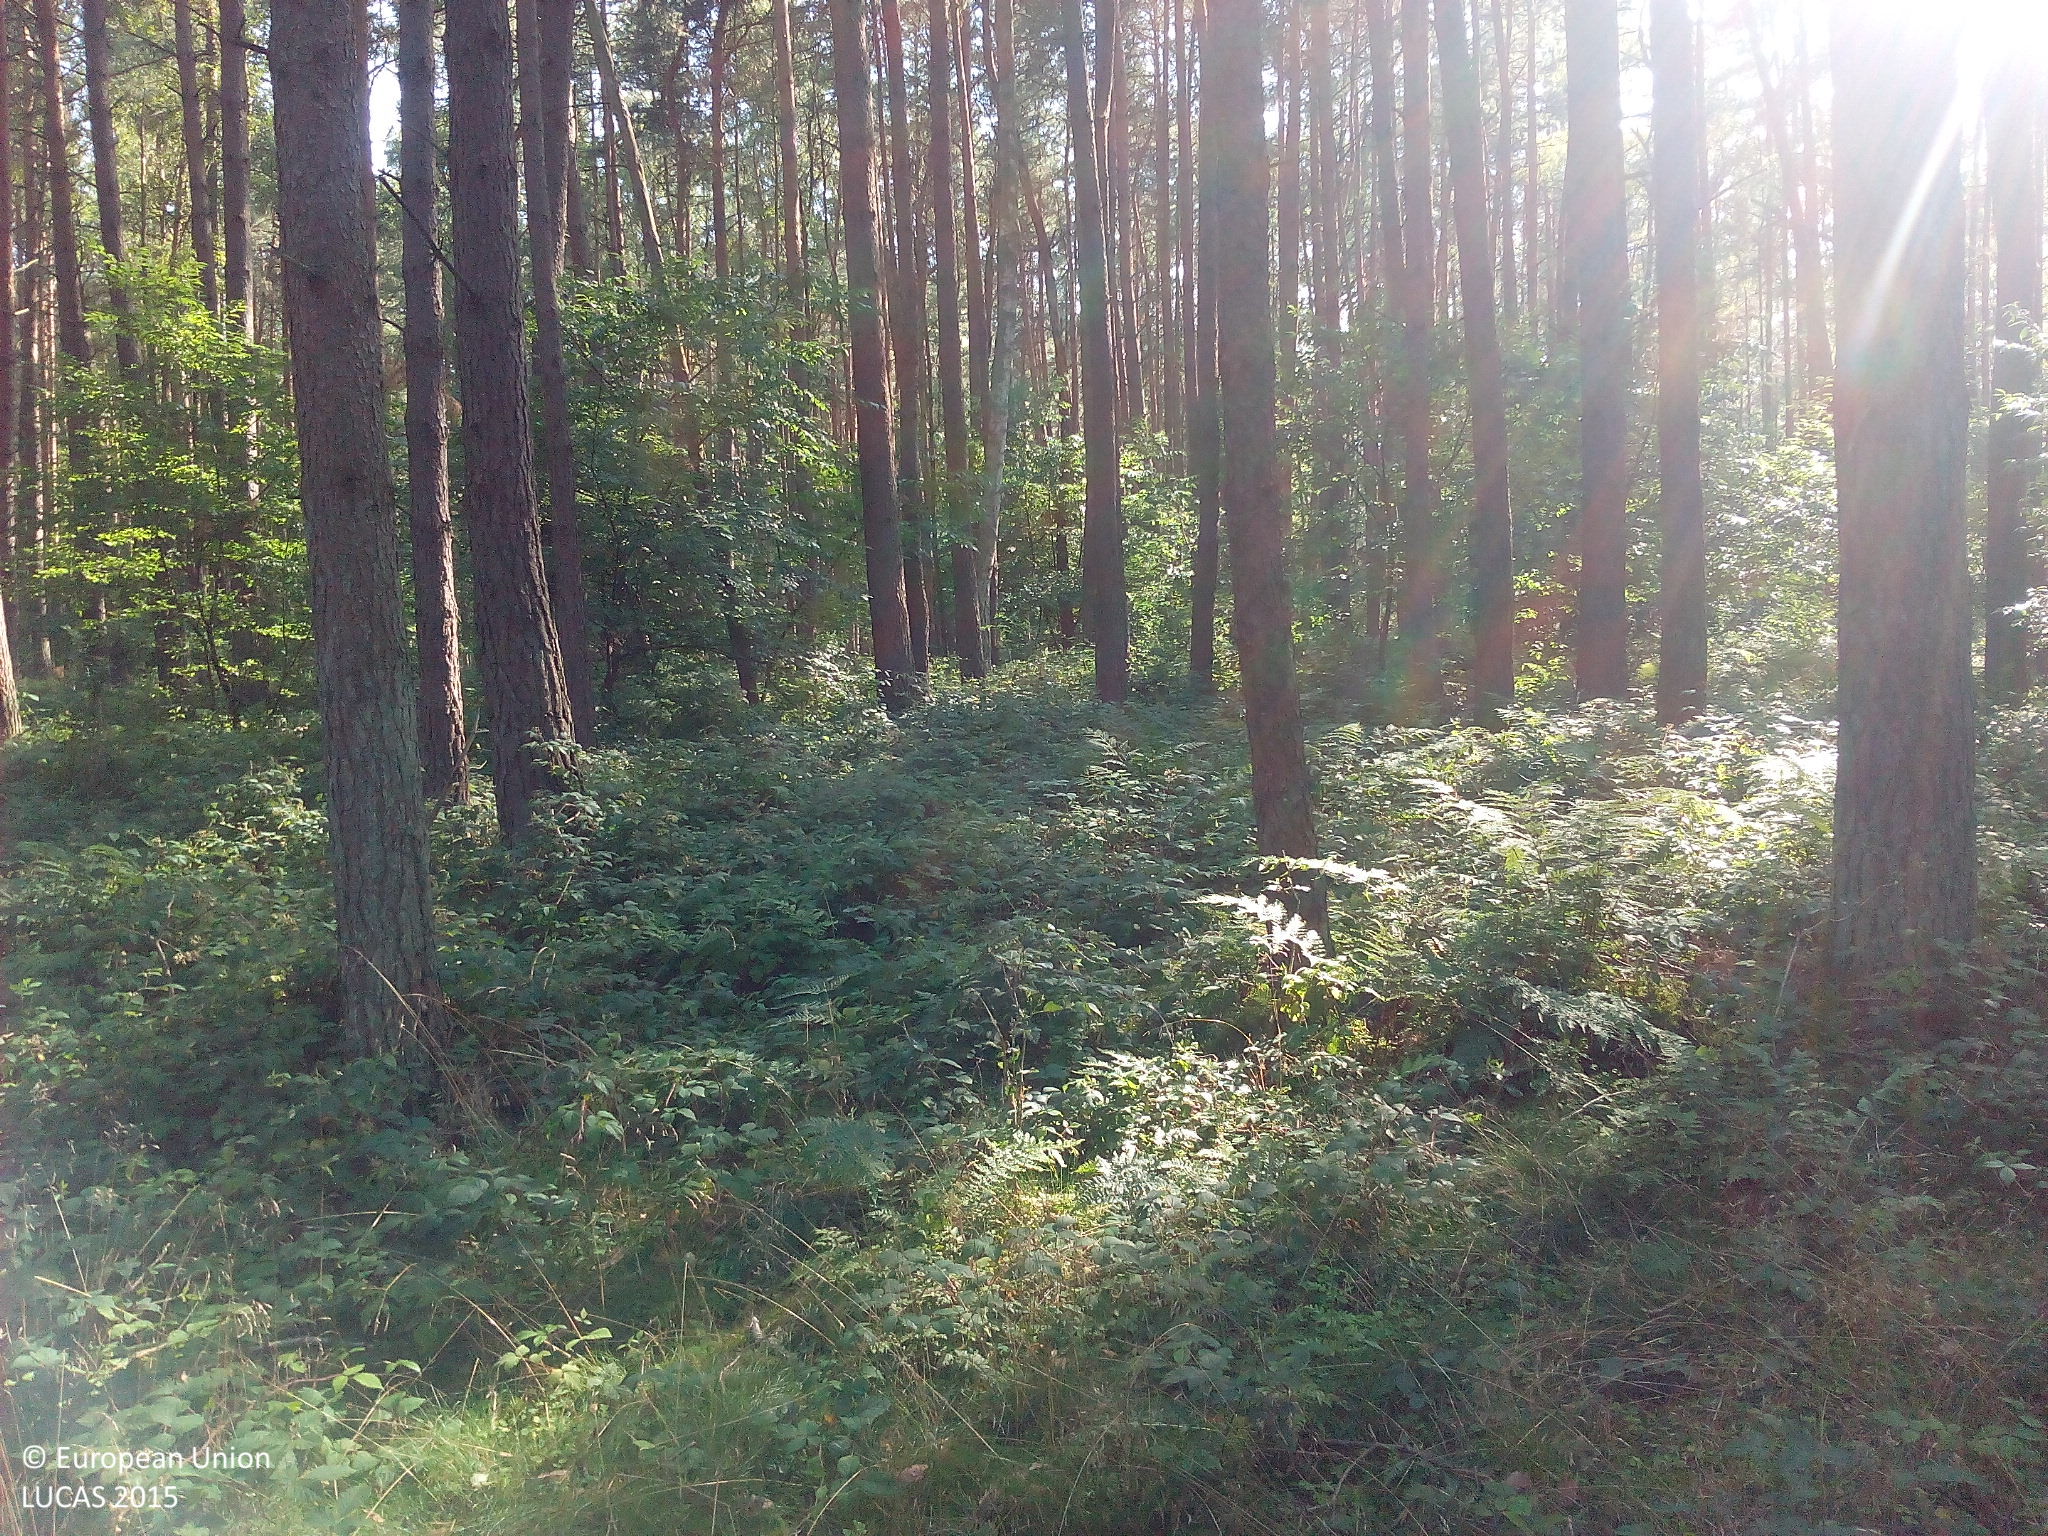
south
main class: Woodland
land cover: Pine dominated mixed woodland
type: hemiboreal forest and nemoral coniferous forest and mixed broadleaved-coniferous forest
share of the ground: > 75 %
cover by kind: coniferous forest trees 60 %, broadleaved forest trees 25 %, herbaceous plants 10 %, shrubs 5 %
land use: Forestry
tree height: > 5 m
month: August
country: DE
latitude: 53.5945
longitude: 12.3714
